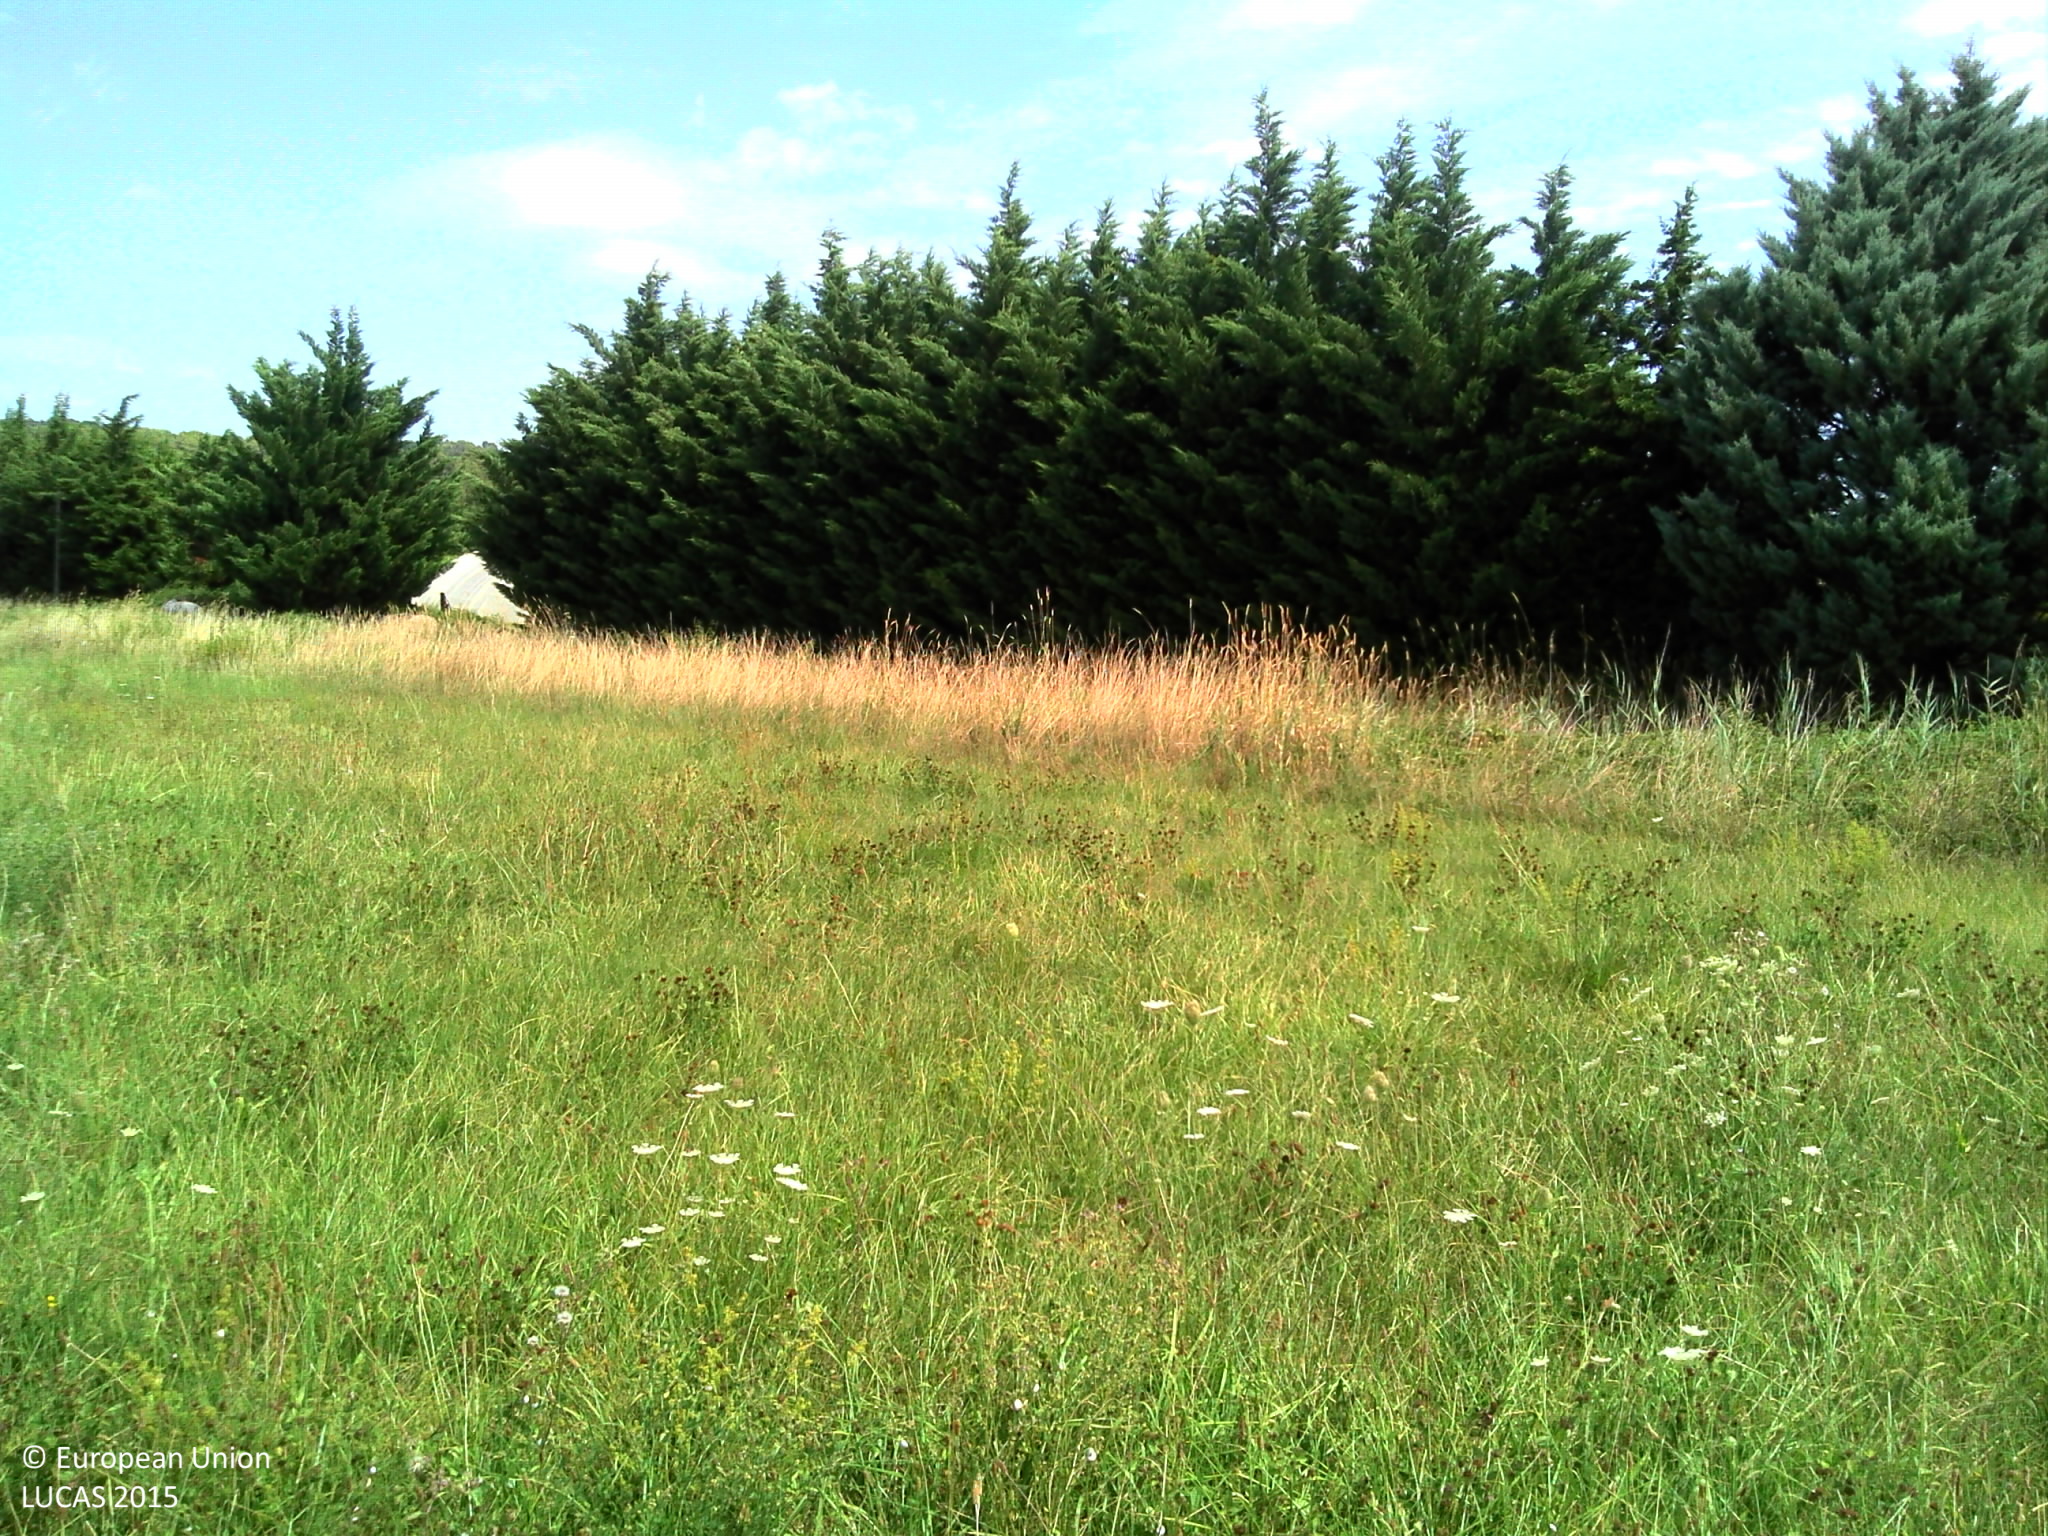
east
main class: Grassland
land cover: Grassland without tree/shrub cover
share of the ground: > 75 %
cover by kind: herbaceous plants 100 %
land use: Agriculture (excluding fallow land and kitchen gardens)
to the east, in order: Grassland without tree/shrub cover; Artificial constructions in urban areas; Sunflower; Tracks; Electric lines; Grass margins; Ditches and canals; Grass margins; Paved roads, cycling and walking lanes; Grass margins; Electric lines; Ditches and canals; Grass margins; Lines of trees; Grassland without tree/shrub cover; Artificial constructions in urban areas; Grassland without tree/shrub cover
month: July
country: FR
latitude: 43.7237
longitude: 5.3789
